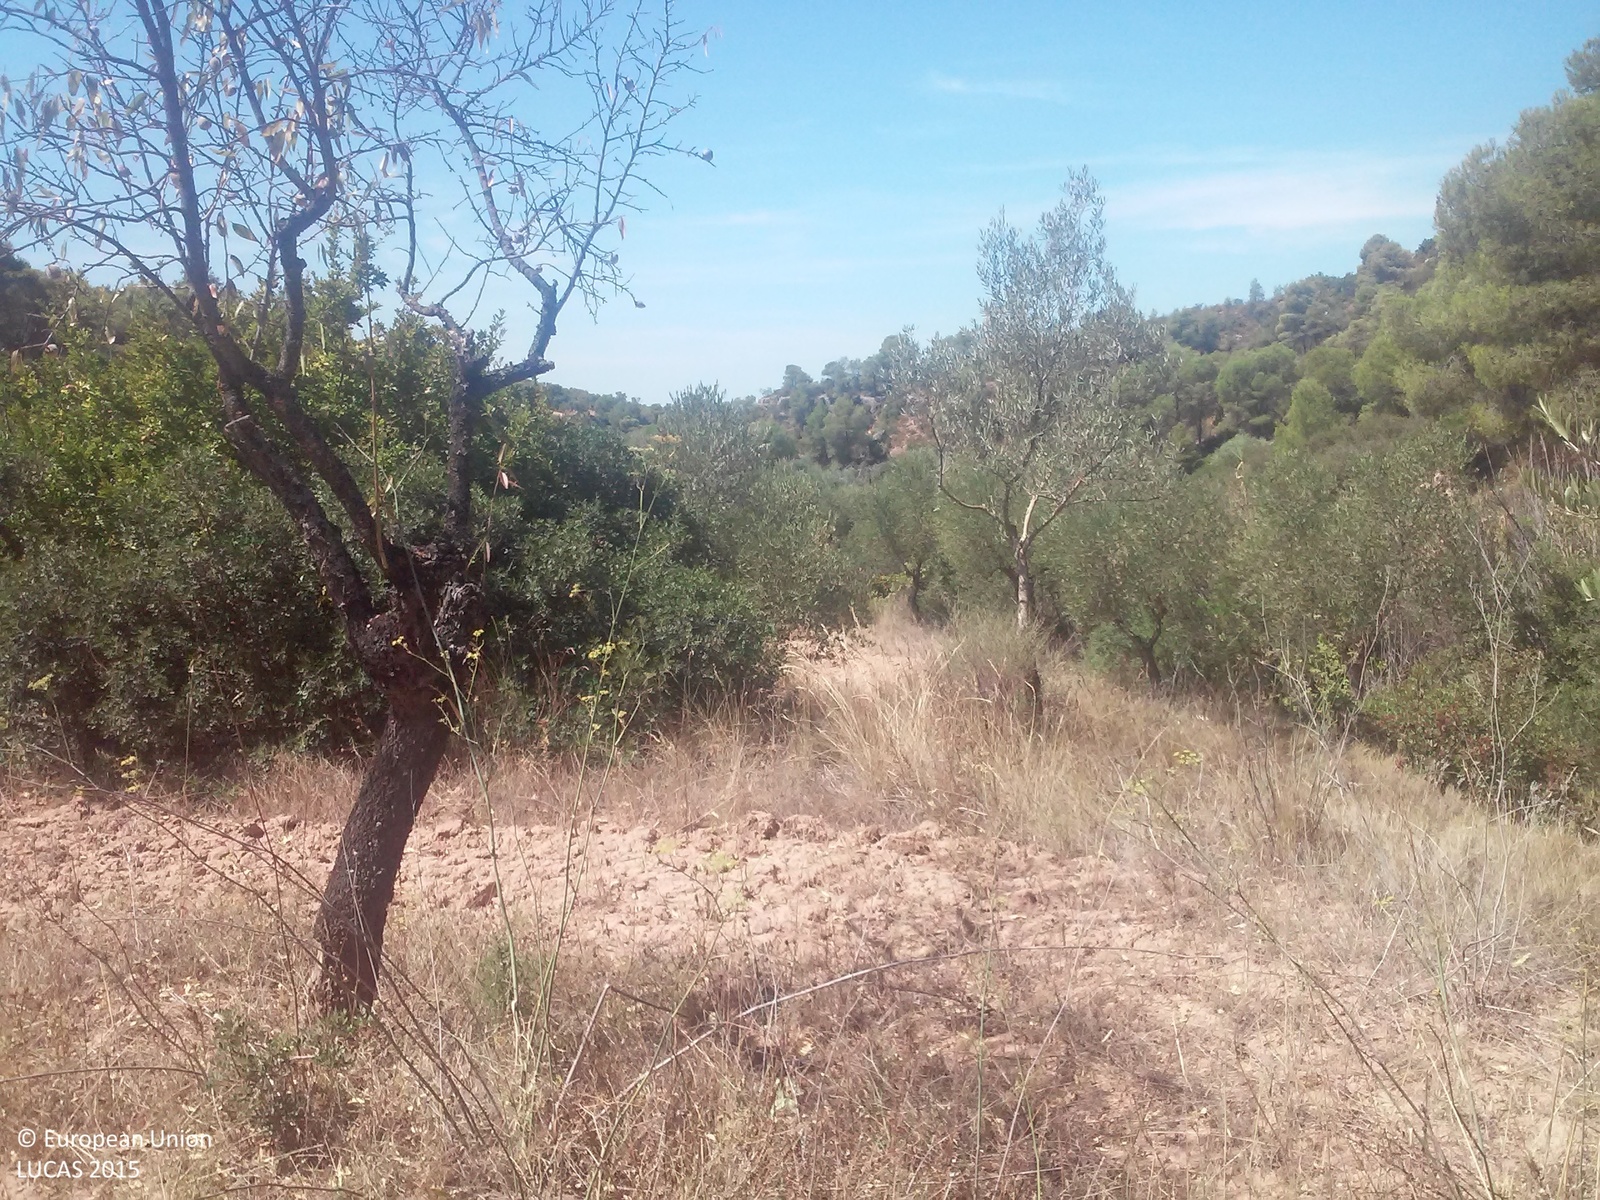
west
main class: Cropland
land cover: Olive groves
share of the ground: < 10 %
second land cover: Nuts trees
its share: < 10 %
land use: Agriculture (excluding fallow land and kitchen gardens)
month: August
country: ES
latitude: 41.3241
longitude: 0.5874
